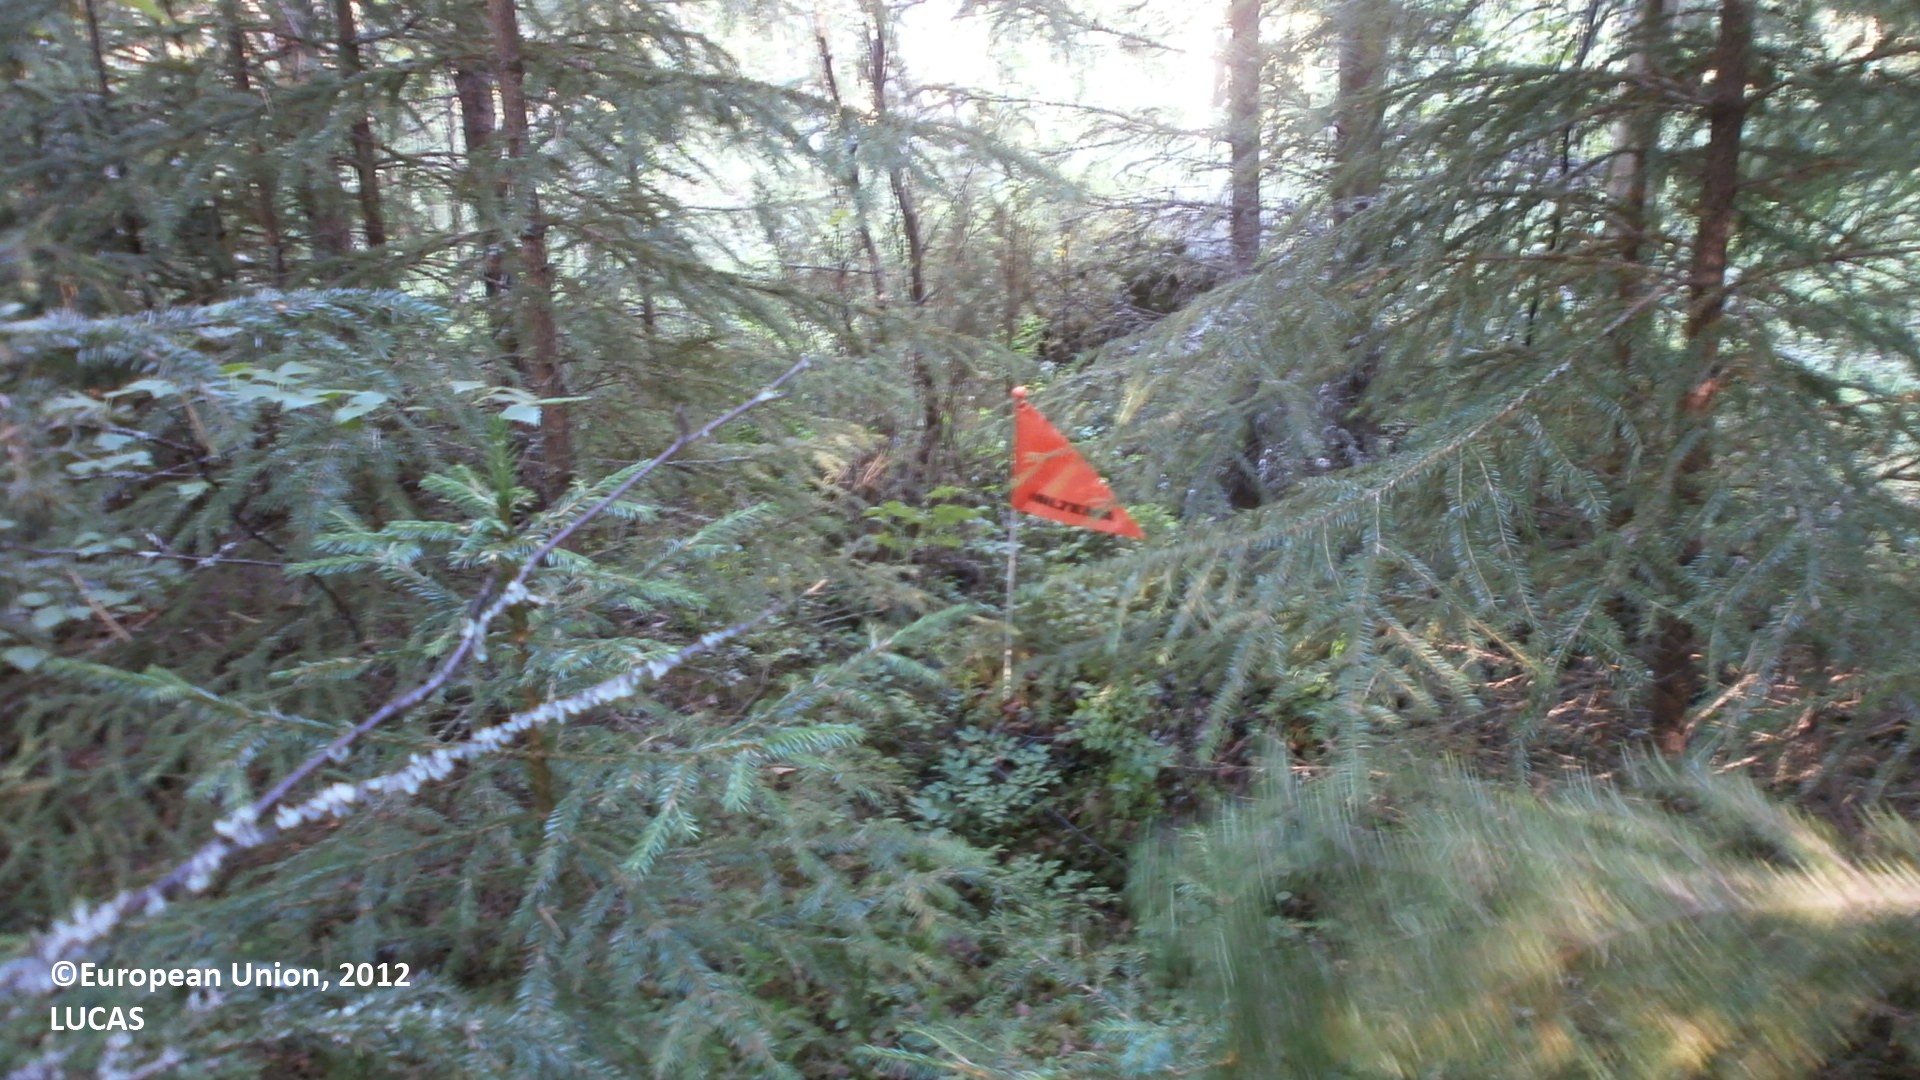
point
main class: Woodland
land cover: Pine dominated coniferous woodland
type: boreal forest
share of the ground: > 75 %
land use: Forestry
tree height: > 5 m
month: July
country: FI
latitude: 64.1015
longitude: 23.6218
